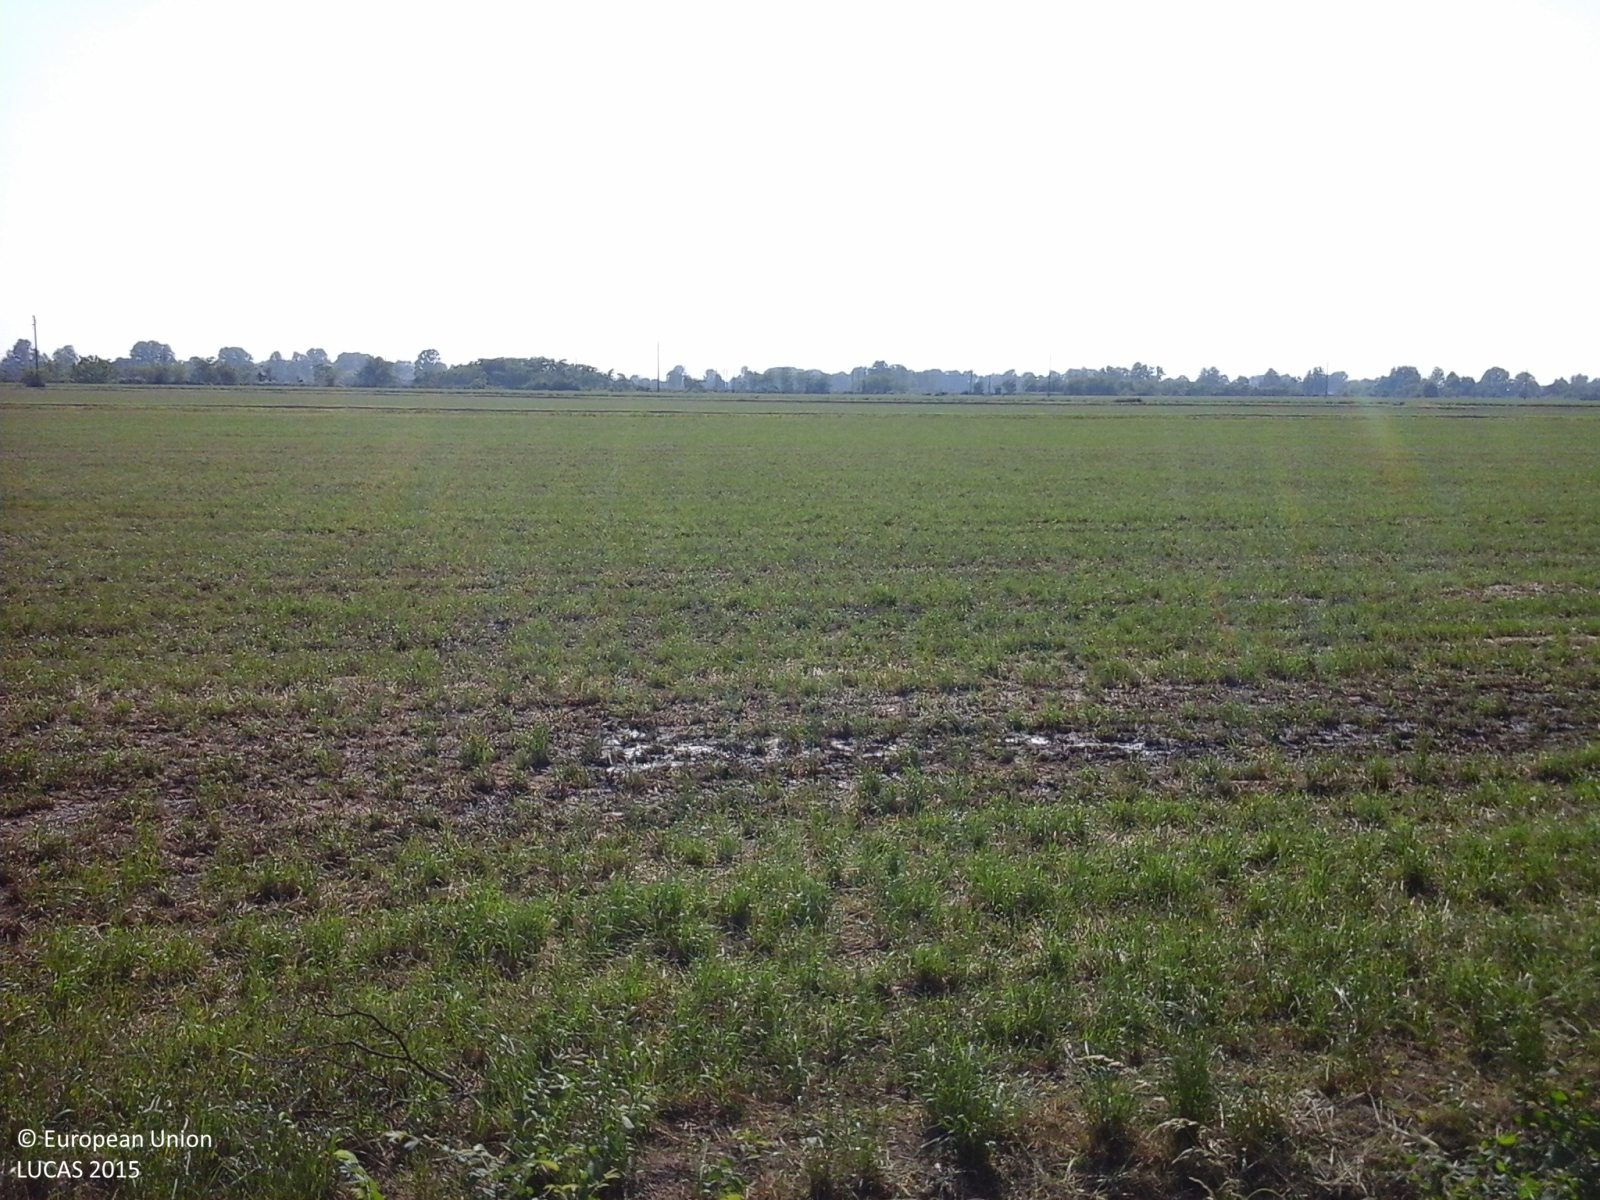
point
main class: Cropland
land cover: Temporary grasslands
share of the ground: > 75 %
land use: Agriculture (excluding fallow land and kitchen gardens)
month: May
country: IT
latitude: 45.2153
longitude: 9.6060
